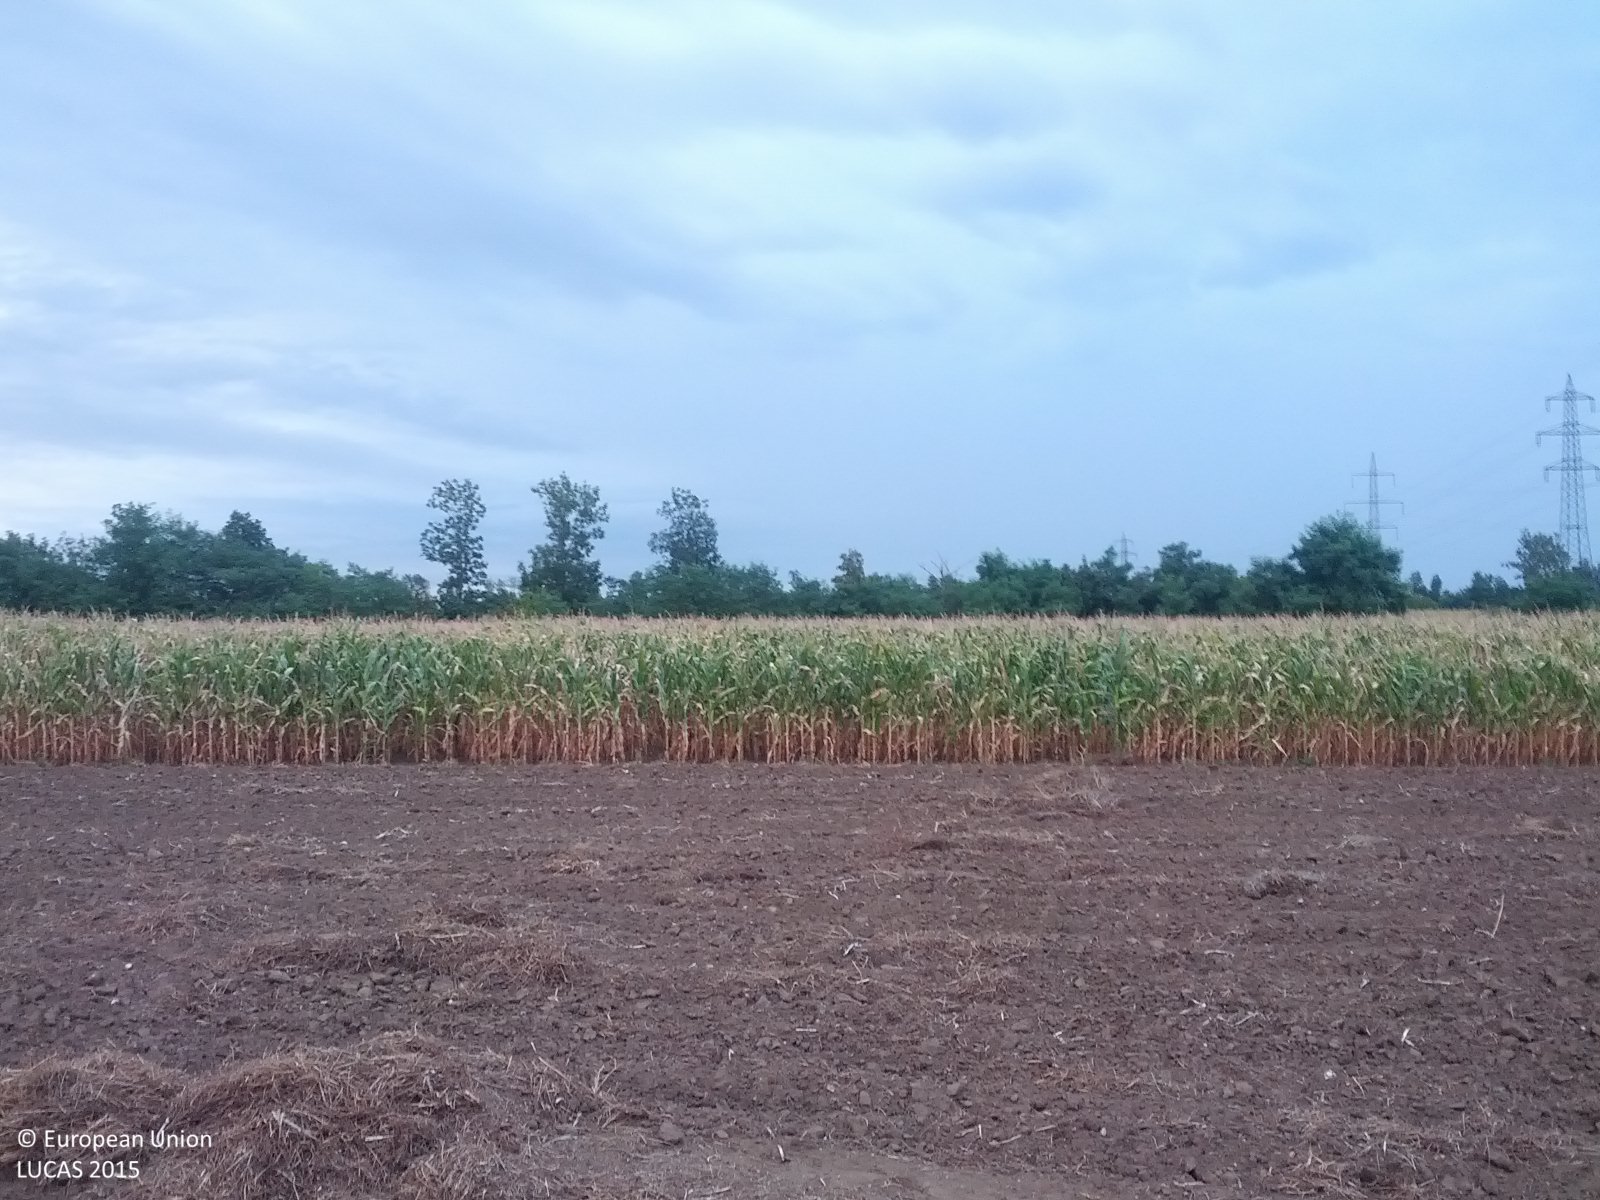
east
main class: Cropland
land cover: Other root crops
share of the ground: < 10 %
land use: Agriculture (excluding fallow land and kitchen gardens)
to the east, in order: Other root crops; Maize; Shrubland with sparse tree cover; Maize; Grassland without tree/shrub cover; Other fibre and oleaginous crops; Sunflower
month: July
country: AT
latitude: 48.3552
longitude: 16.5241
